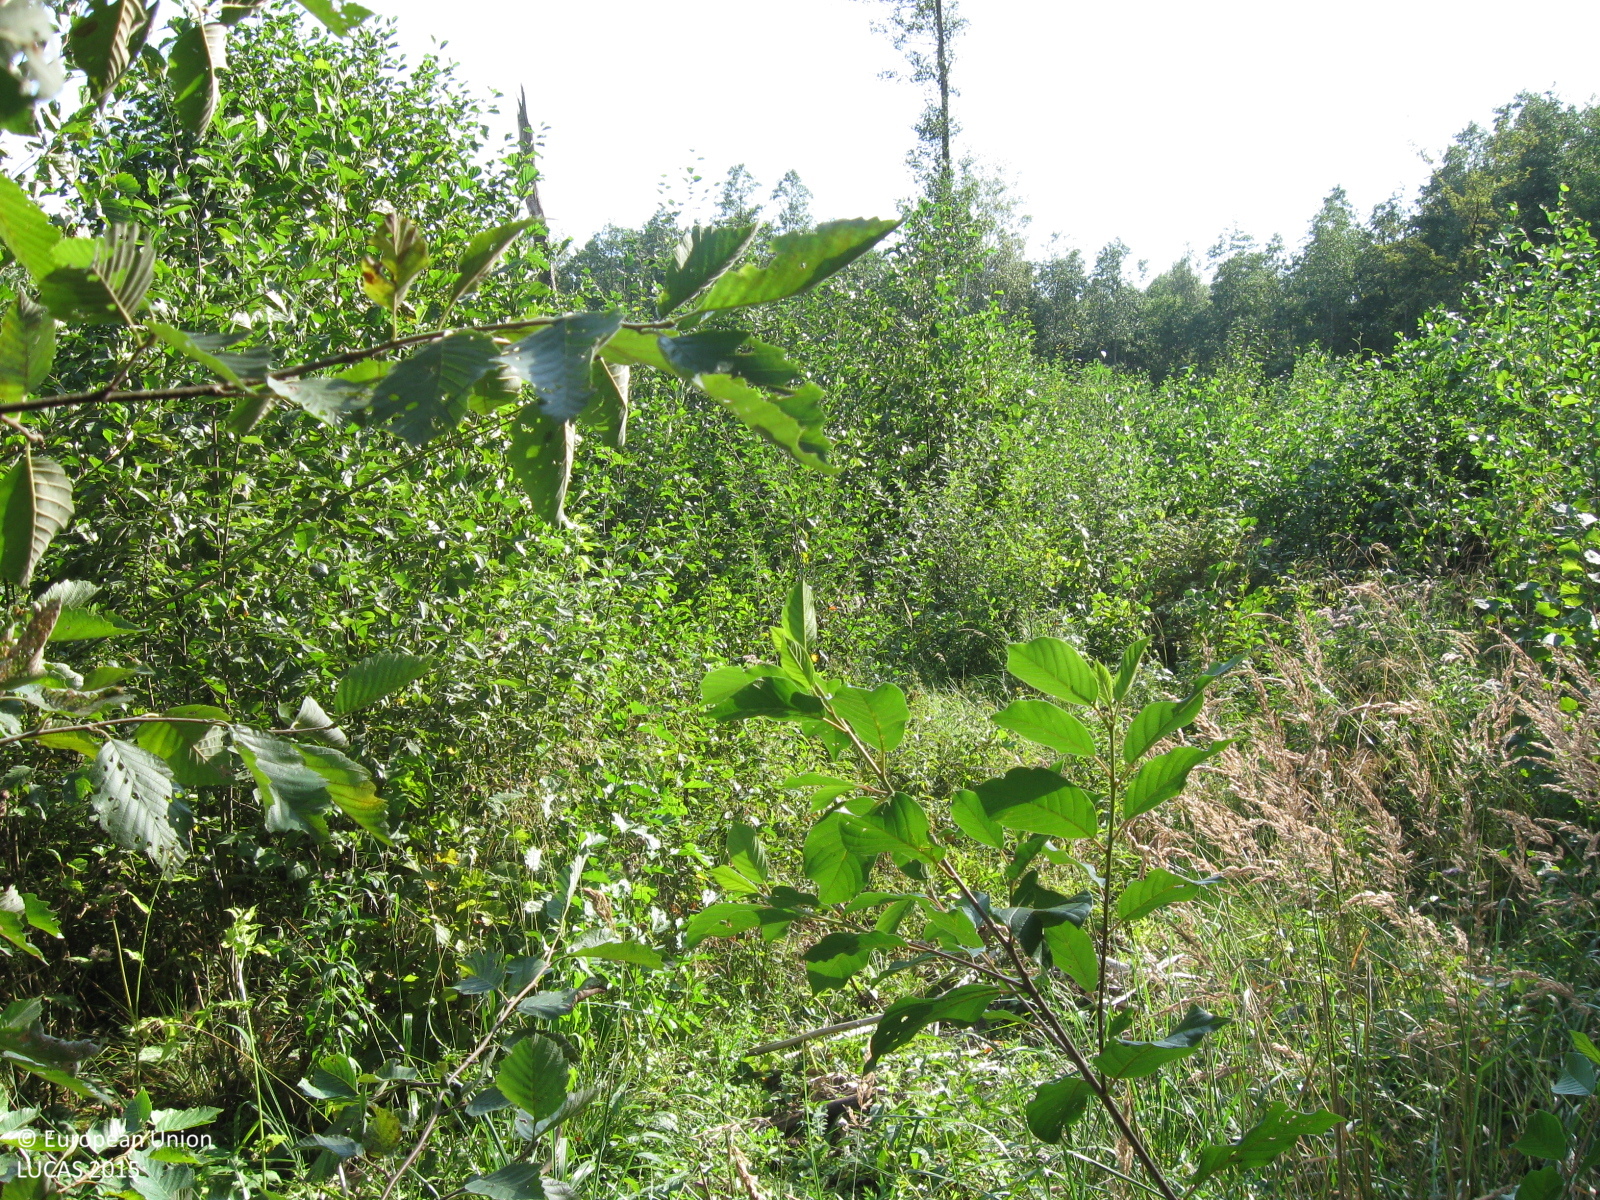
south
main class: Woodland
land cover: Broadleaved woodland
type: non-riverine alder, birch or aspen forest
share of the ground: > 75 %
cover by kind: broadleaved forest trees 85 %, herbaceous plants 10 %, unconsolidated bare surface 5 %
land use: Forestry
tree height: < 5 m
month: August
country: LT
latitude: 55.1464
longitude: 23.1114
